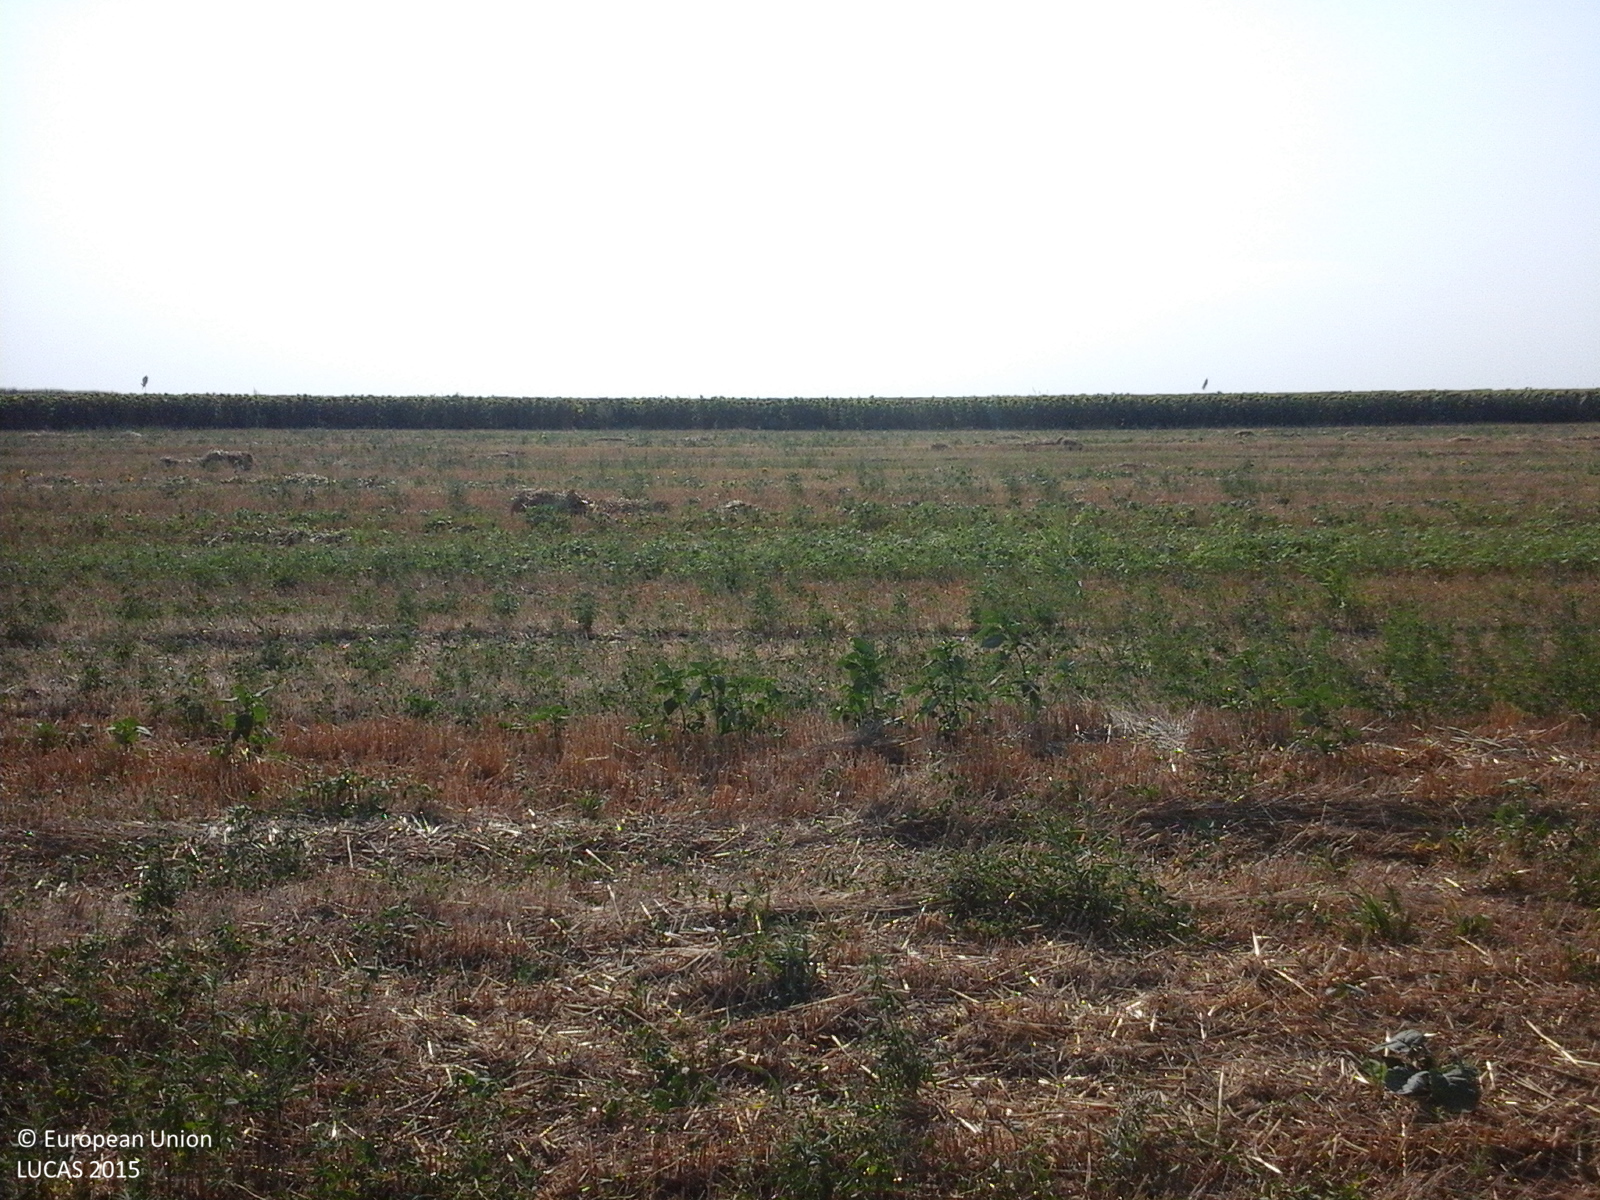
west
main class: Cropland
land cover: Barley
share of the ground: 50 - 75 %
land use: Agriculture (excluding fallow land and kitchen gardens)
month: August
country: RO
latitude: 44.9731
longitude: 28.1088
